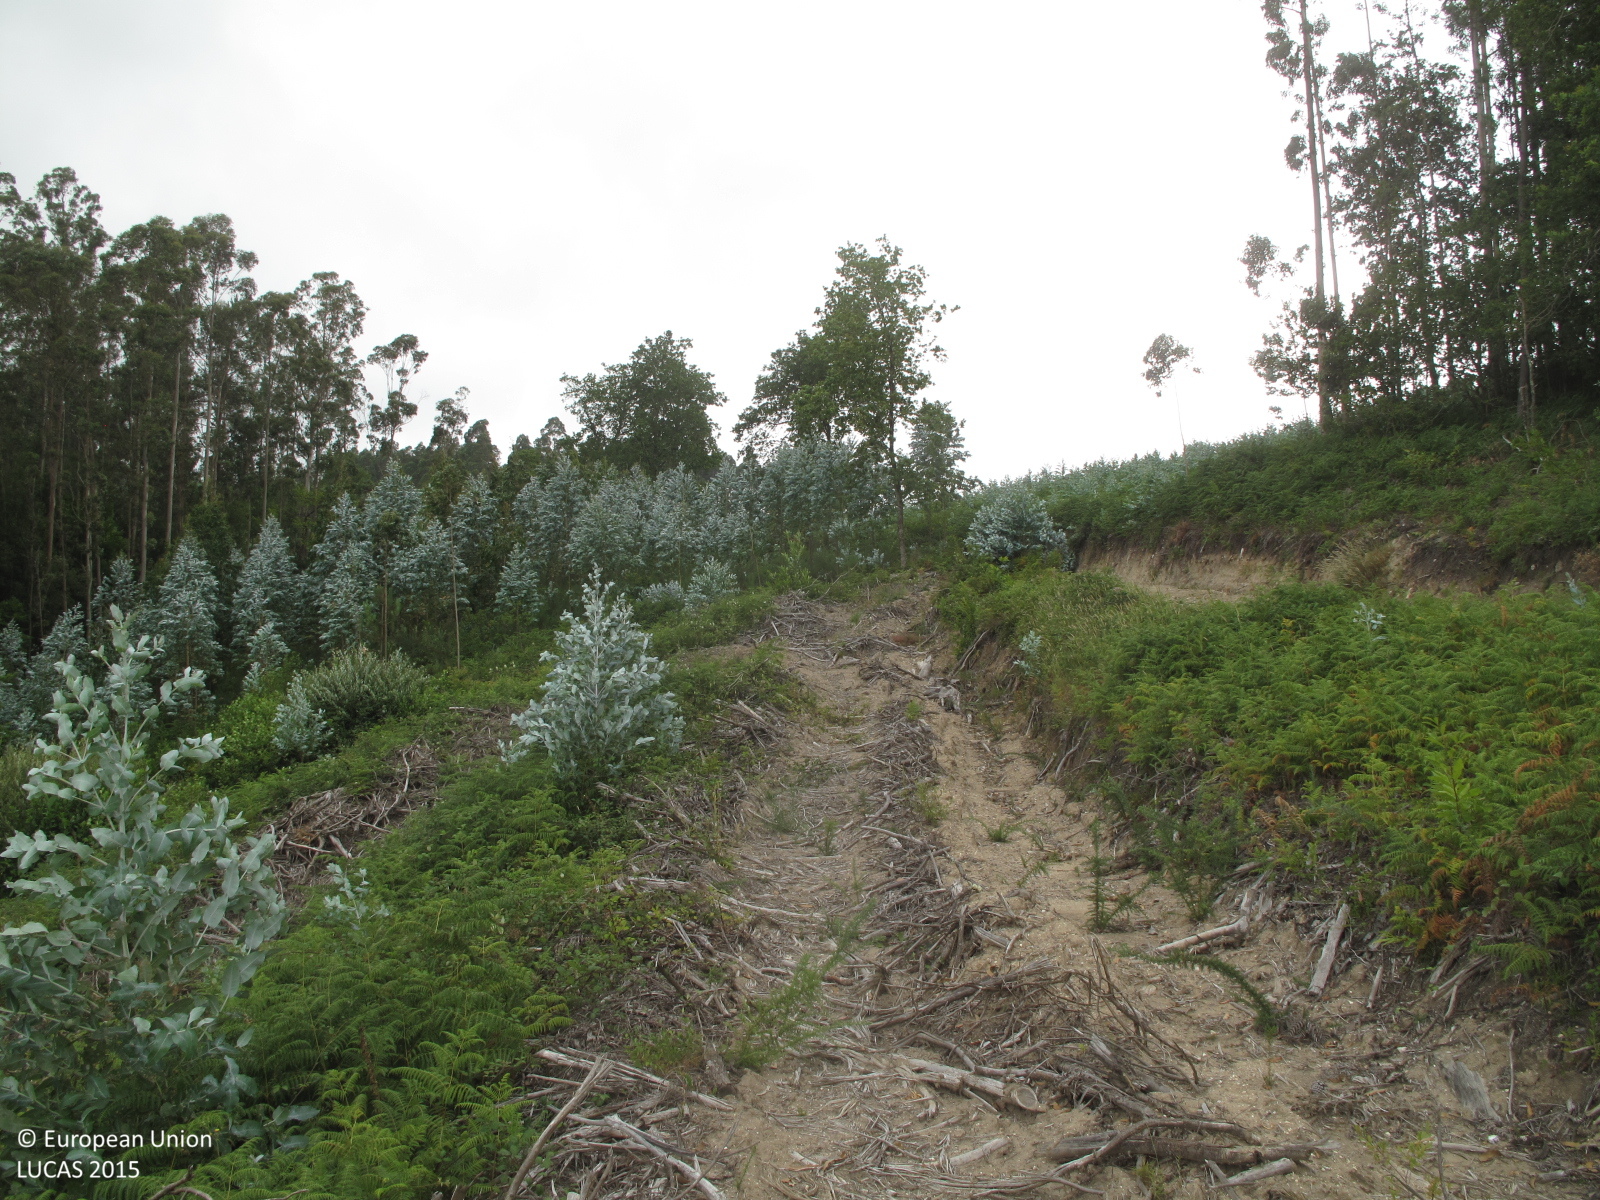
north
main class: Woodland
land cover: Broadleaved woodland
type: exotic forest
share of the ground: 10 - 25 %
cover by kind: herbaceous plants 40 %, broadleaved forest trees 20 %, shrubs 20 %, unconsolidated bare surface 20 %
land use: Forestry
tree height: < 5 m
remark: Clear cut
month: July
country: ES
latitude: 43.3824
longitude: -8.1326
